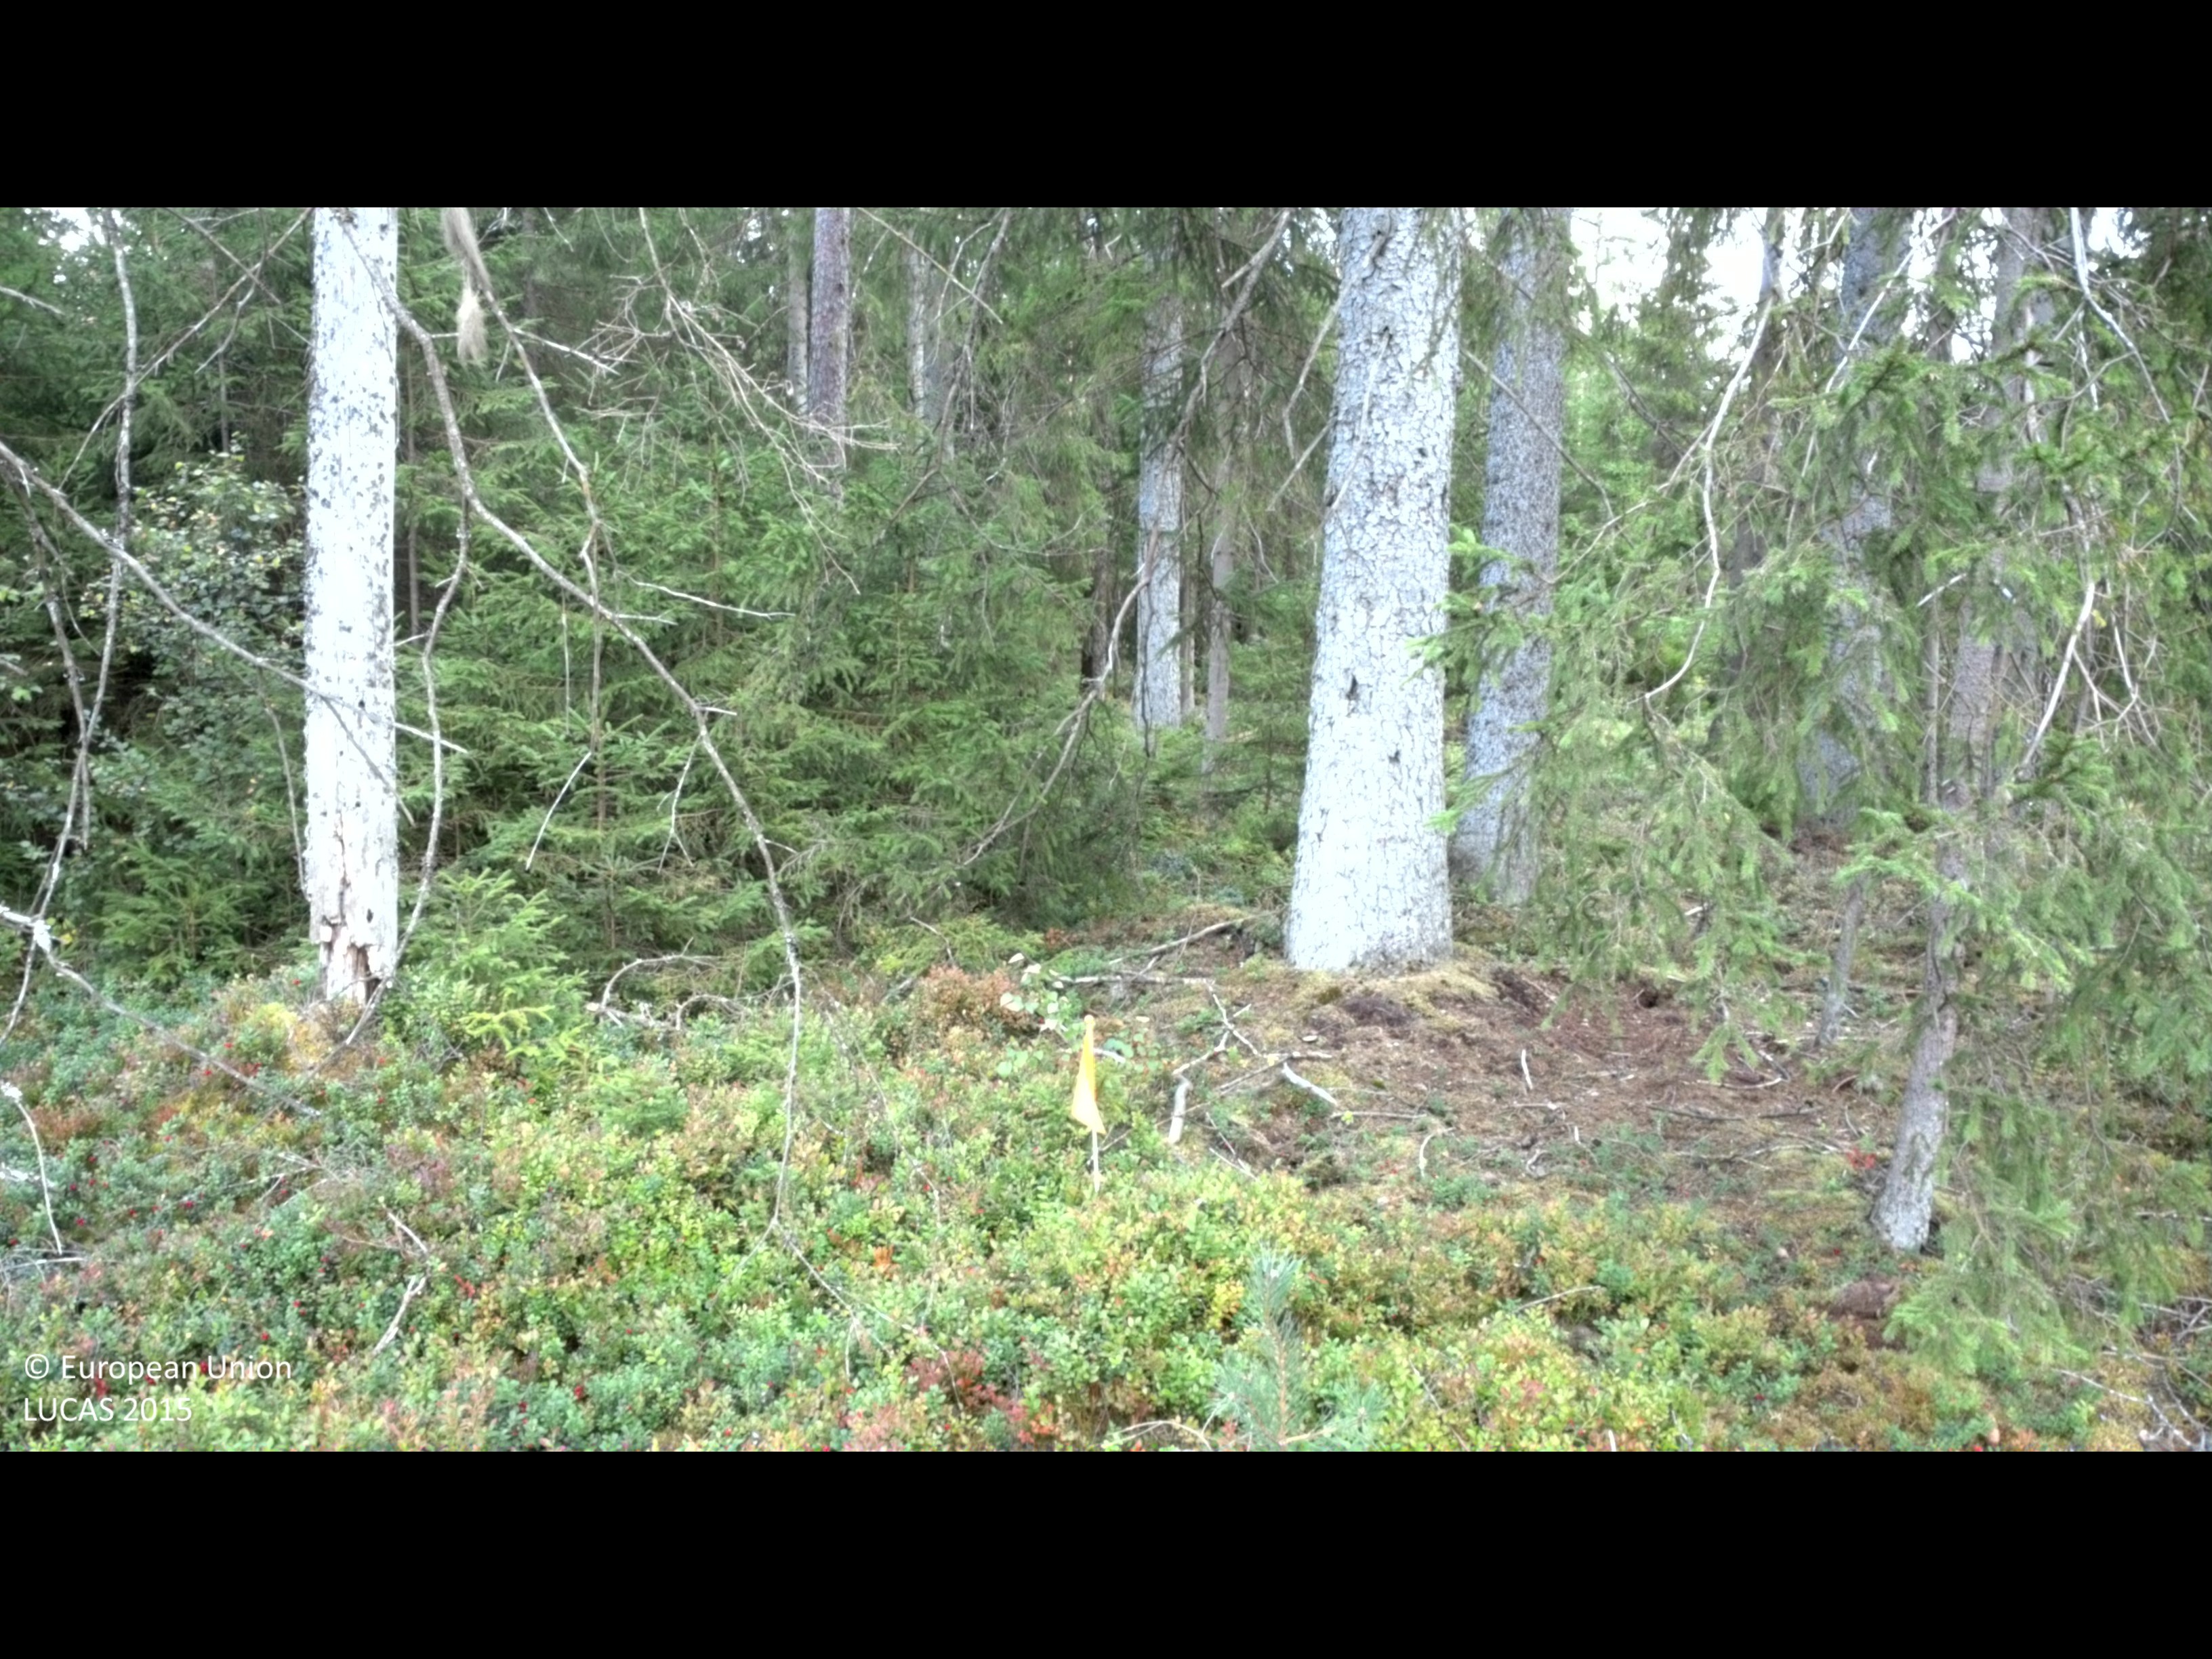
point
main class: Woodland
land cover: Spruce dominated coniferous woodland
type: boreal forest
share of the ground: 50 - 75 %
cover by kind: coniferous forest trees 70 %, shrubs 30 %
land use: Forestry
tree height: > 5 m
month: August
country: SE
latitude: 57.1751
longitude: 13.8169
